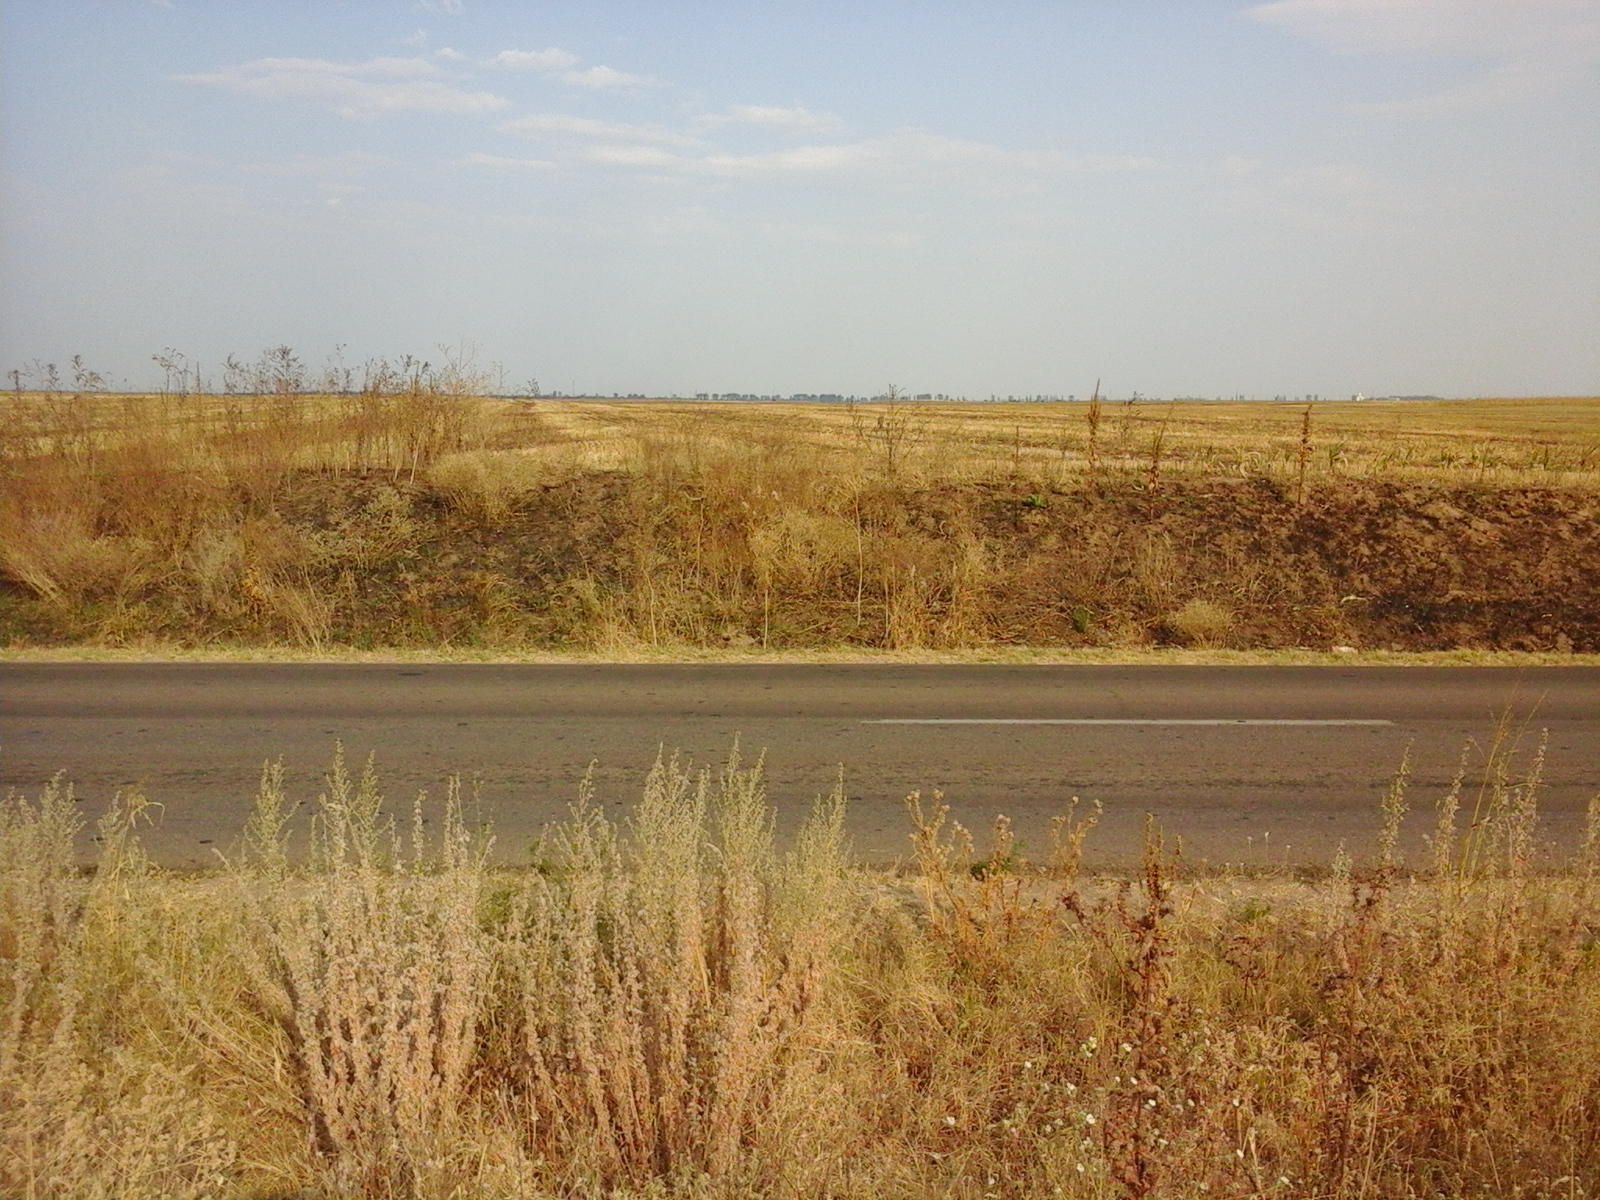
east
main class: Cropland
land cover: Maize
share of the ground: > 75 %
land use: Agriculture (excluding fallow land and kitchen gardens)
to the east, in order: Maize; Spontaneously vegetated surfaces; Paved roads, cycling and walking lanes; Spontaneously vegetated surfaces; Common wheat
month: August
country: RO
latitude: 44.0655
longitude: 23.3687
